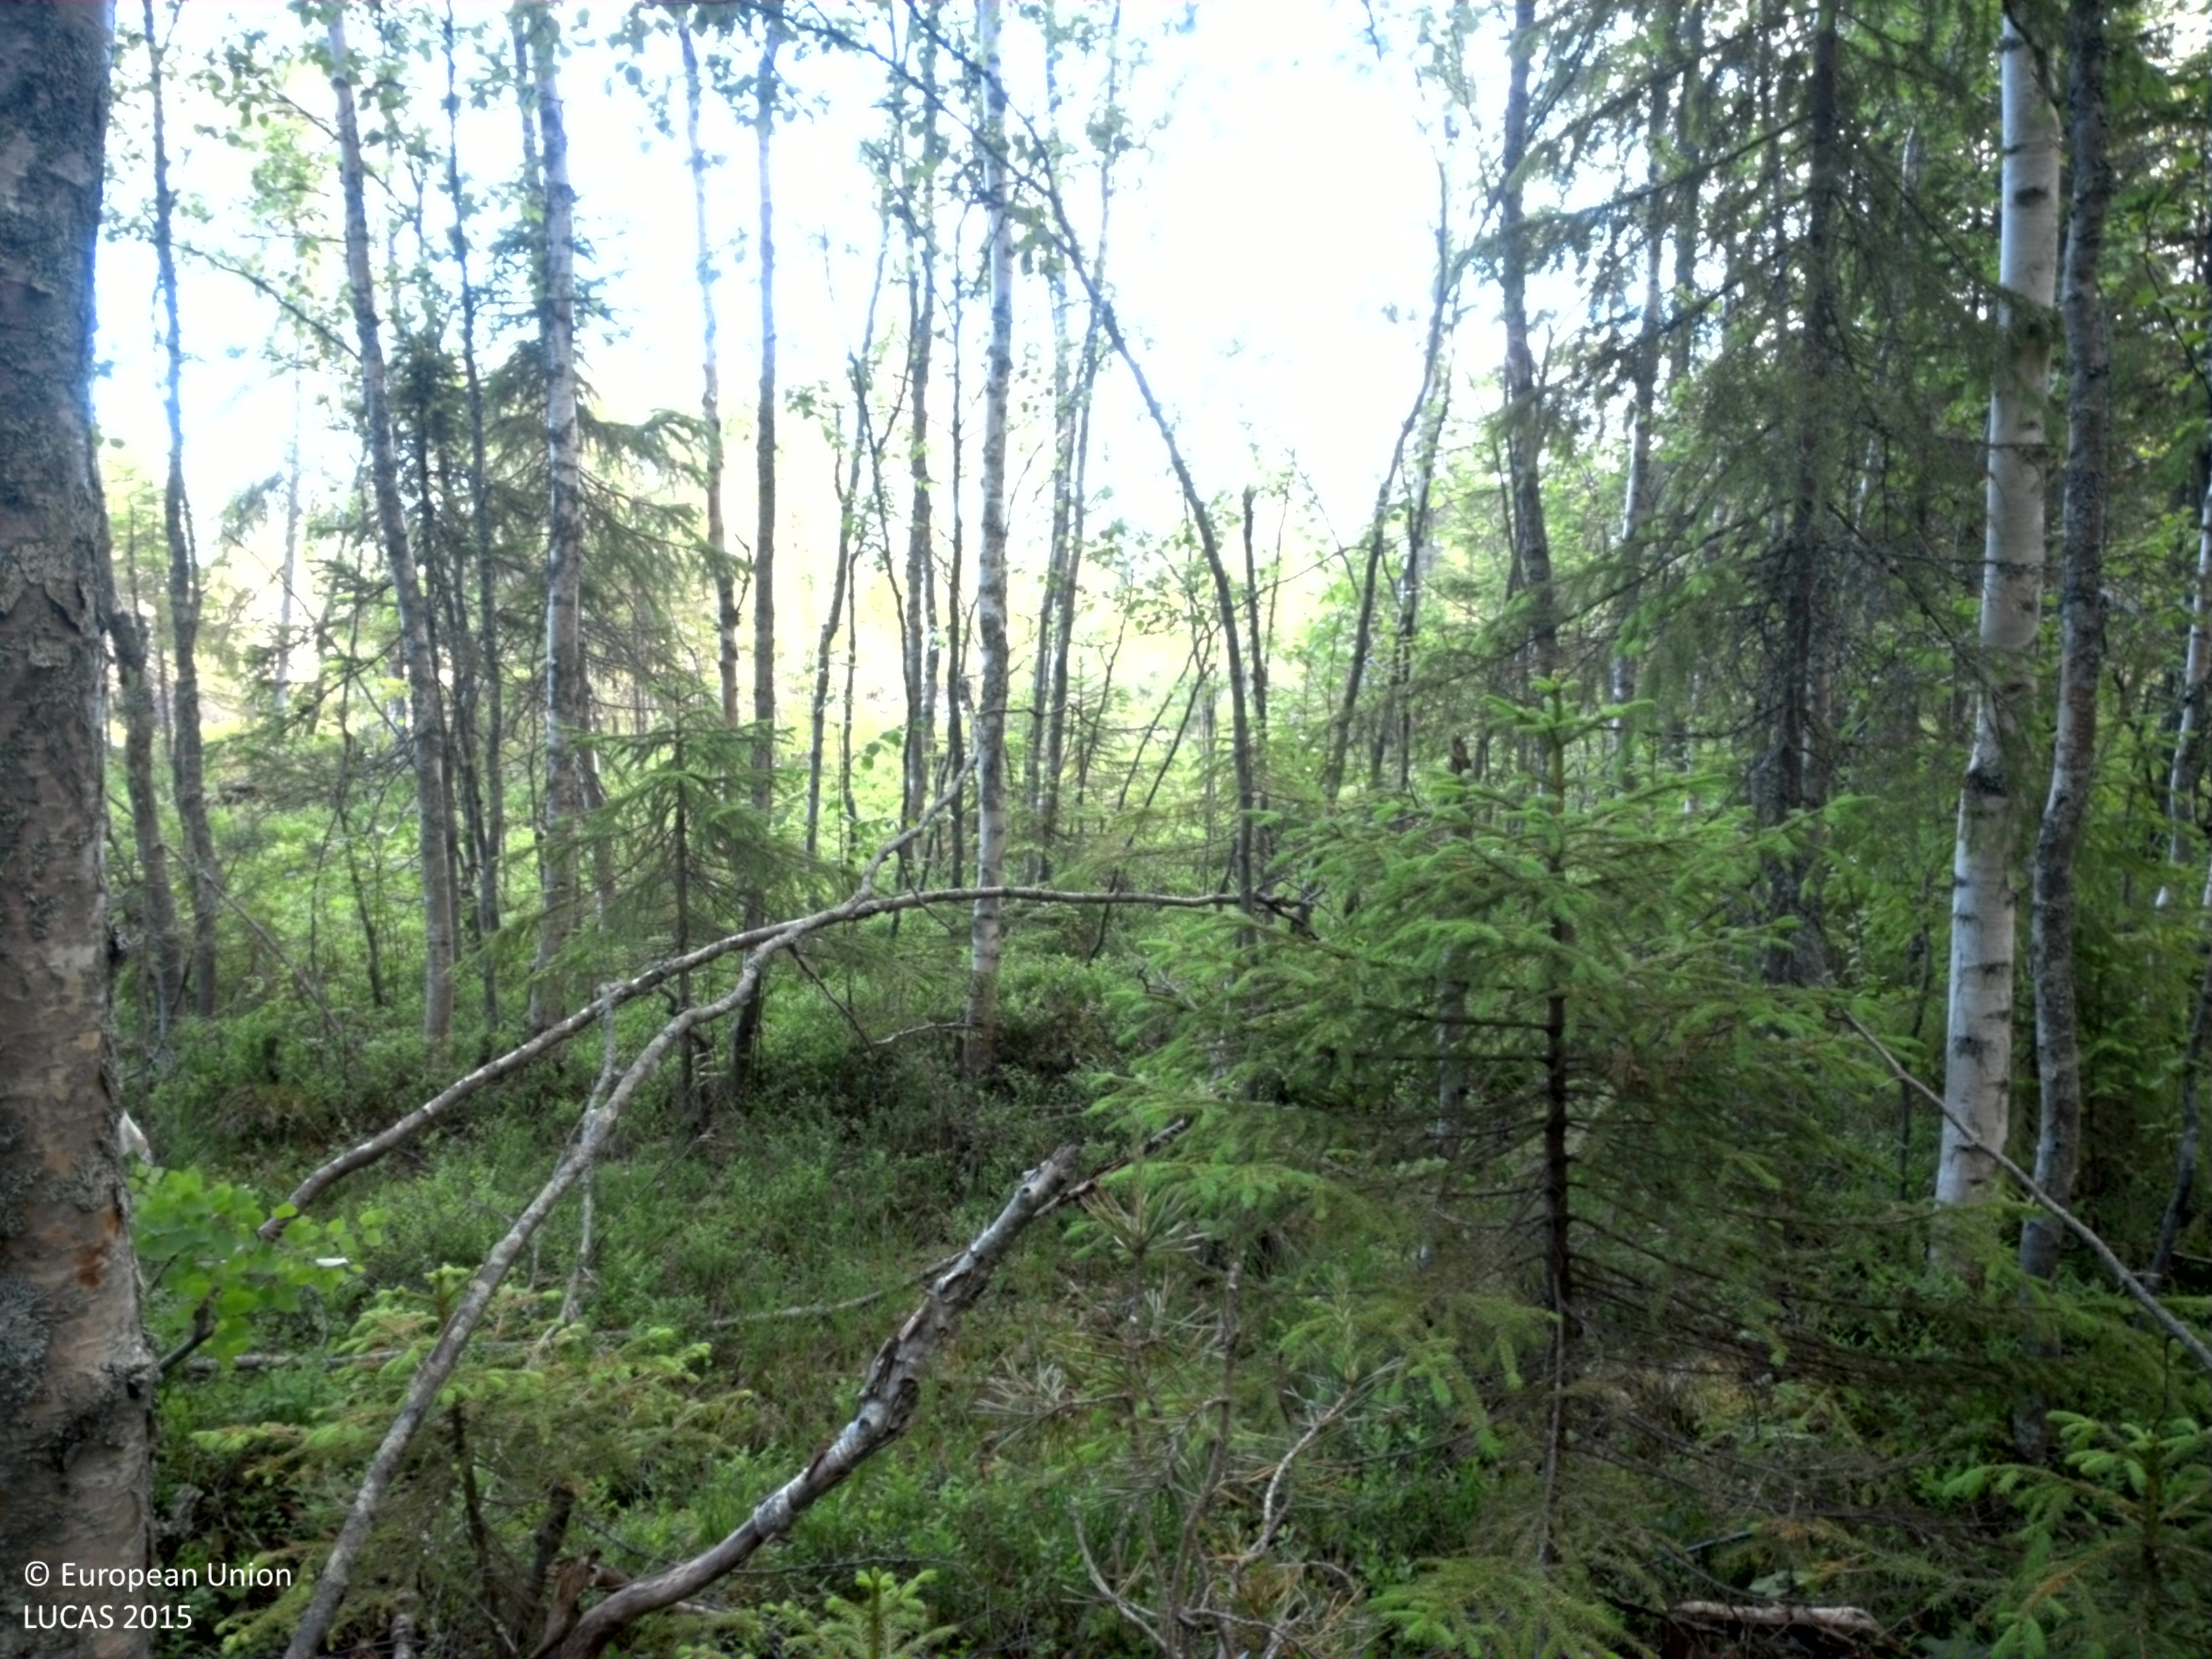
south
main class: Woodland
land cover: Spruce dominated mixed woodland
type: boreal forest
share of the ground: > 75 %
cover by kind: coniferous forest trees 50 %, broadleaved forest trees 35 %, shrubs 15 %
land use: Forestry
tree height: > 5 m
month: June
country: SE
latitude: 64.2527
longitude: 20.7306
